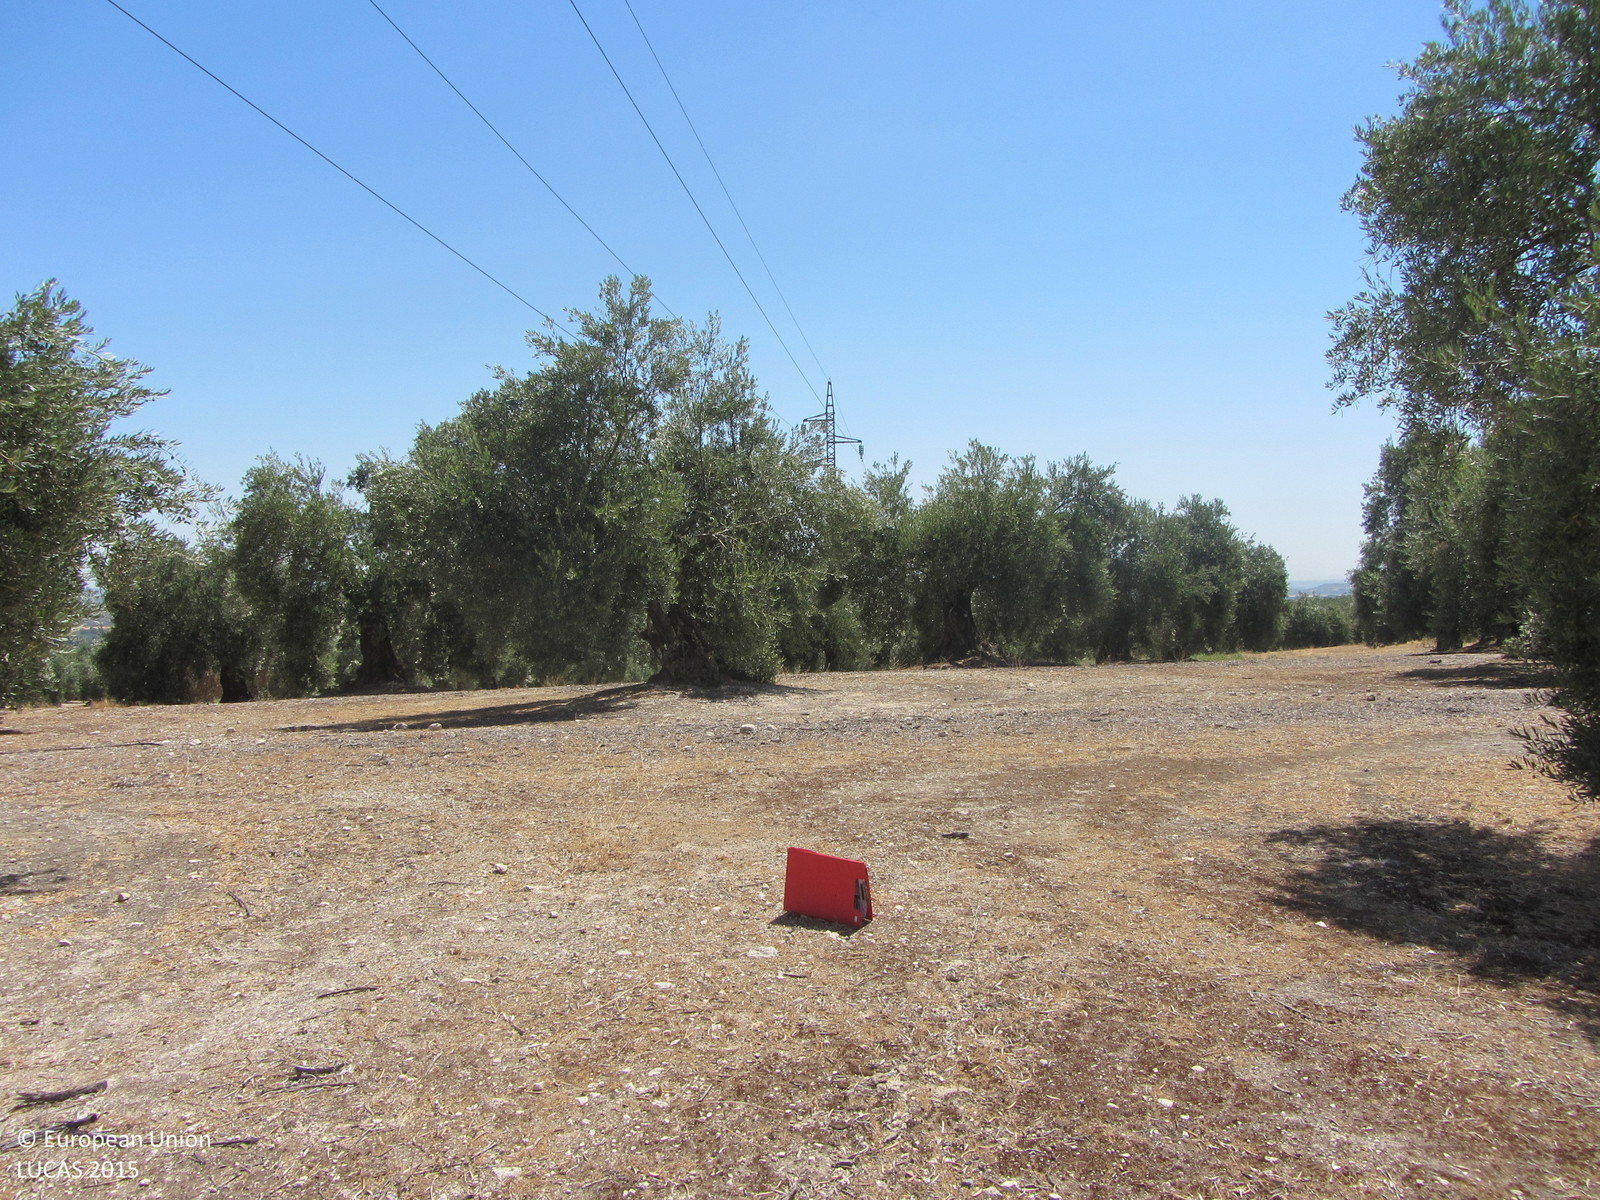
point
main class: Cropland
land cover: Olive groves
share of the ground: 25 - 50 %
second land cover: Other bare soil
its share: > 75 %
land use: Agriculture (excluding fallow land and kitchen gardens)
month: July
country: ES
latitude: 37.9972
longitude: -3.8405
